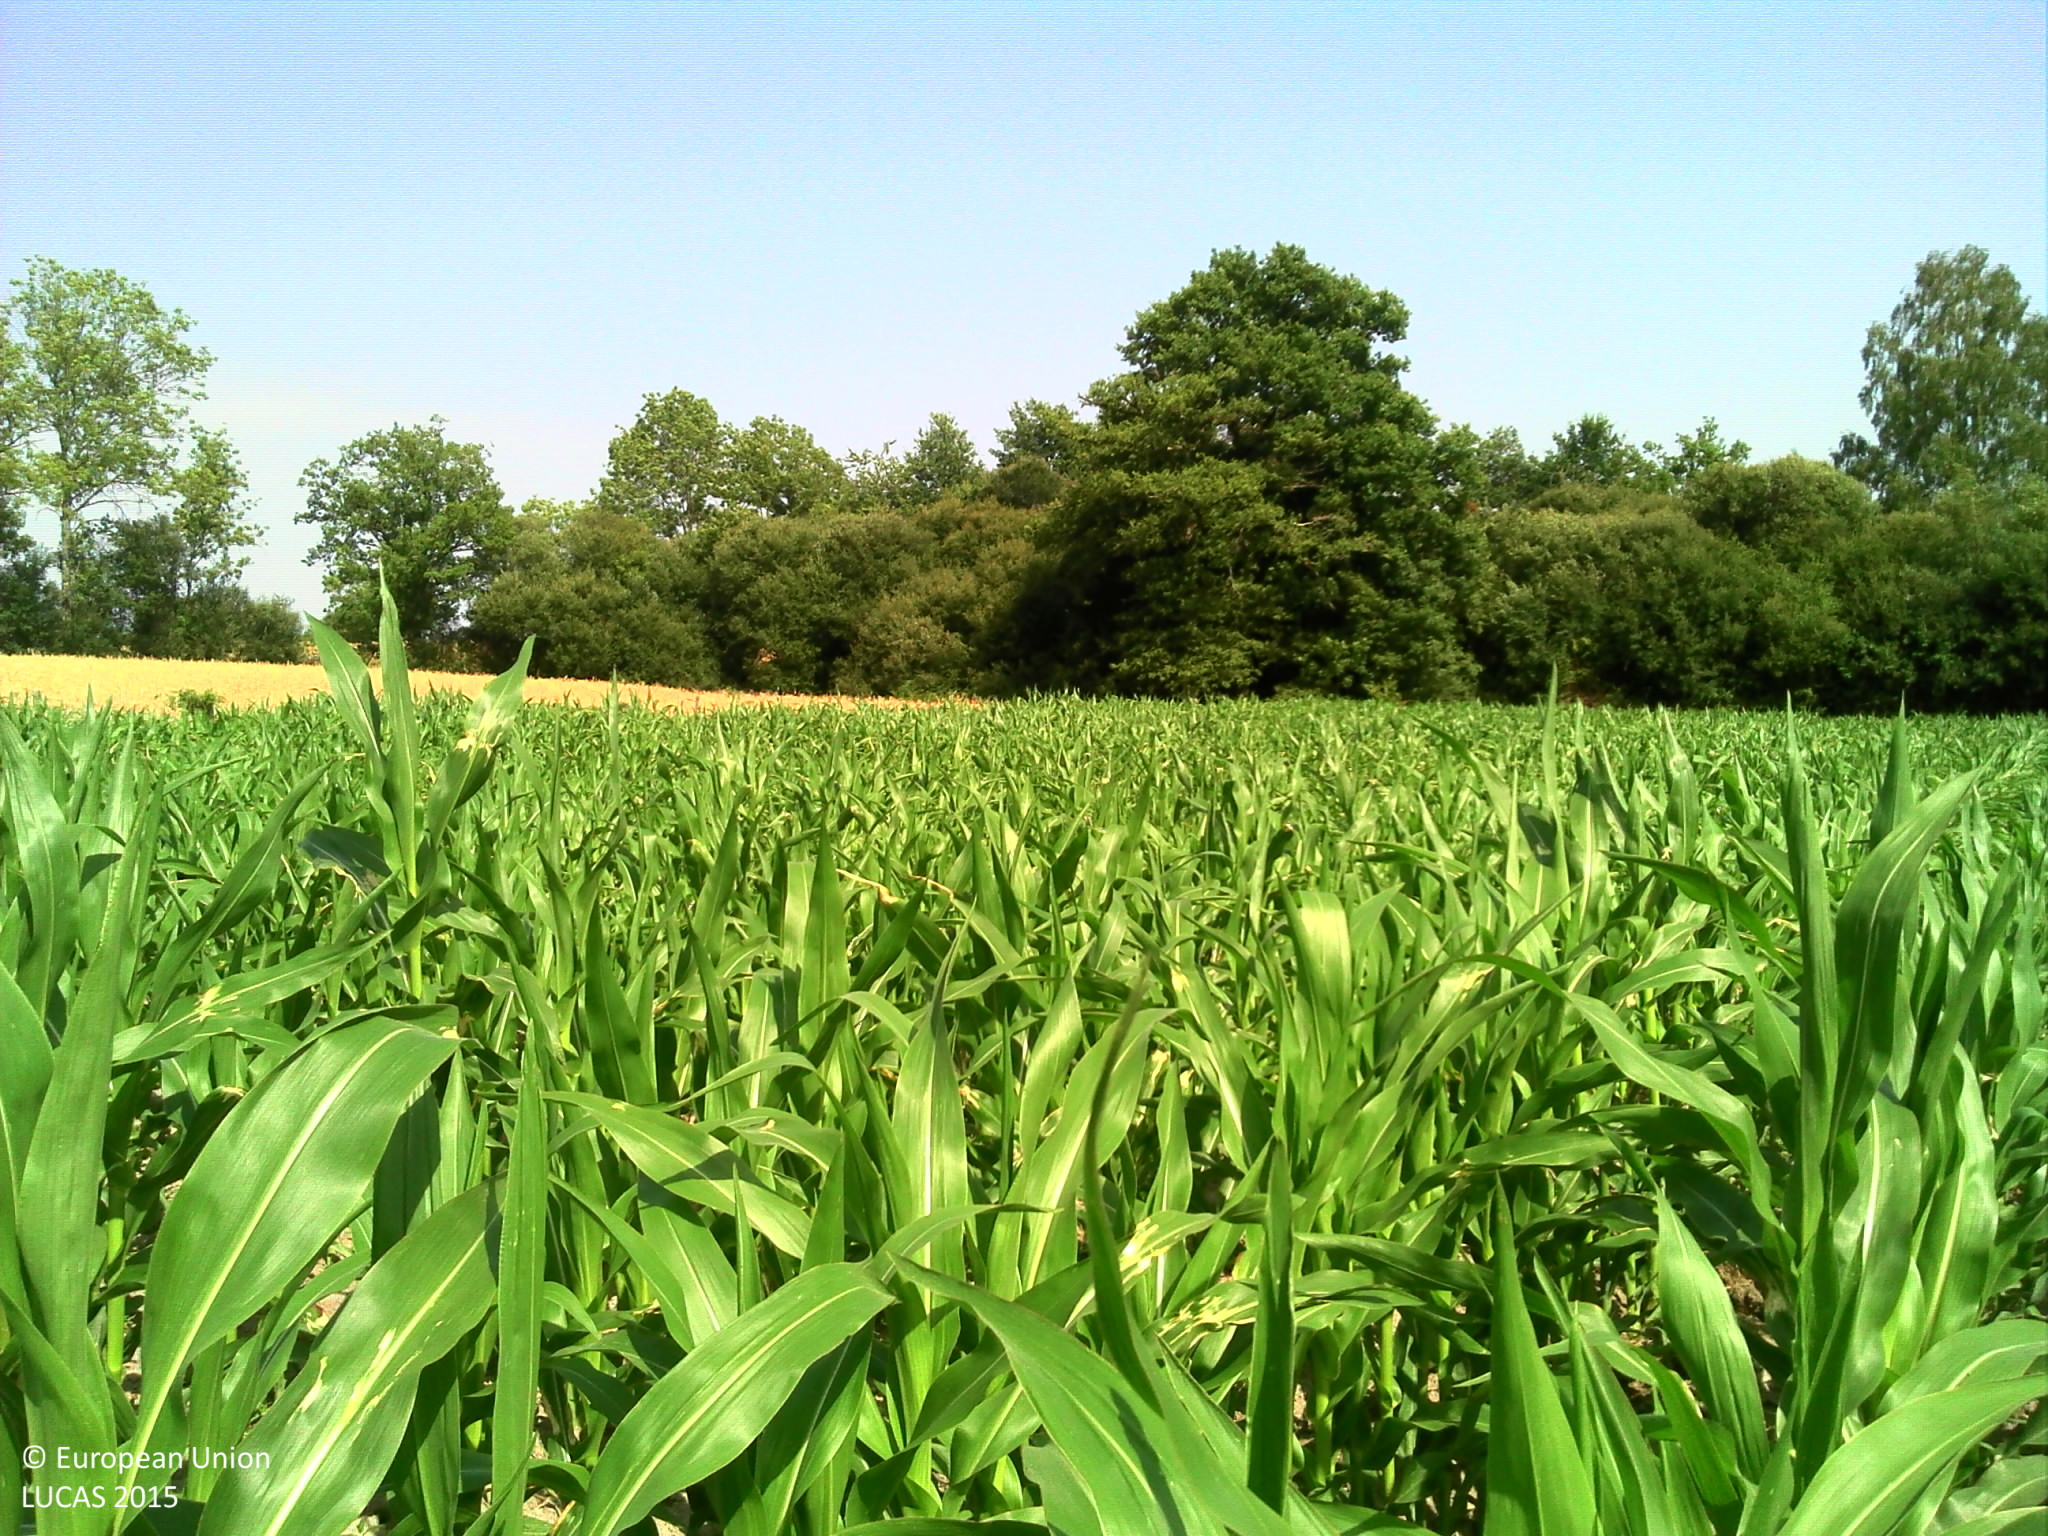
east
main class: Cropland
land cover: Maize
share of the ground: > 75 %
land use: Agriculture (excluding fallow land and kitchen gardens)
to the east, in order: Maize; Fences; Common wheat; Lines of trees; Spontaneously vegetated surfaces; Grassland without tree/shrub cover
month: July
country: FR
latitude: 45.7762
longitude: 1.0515
